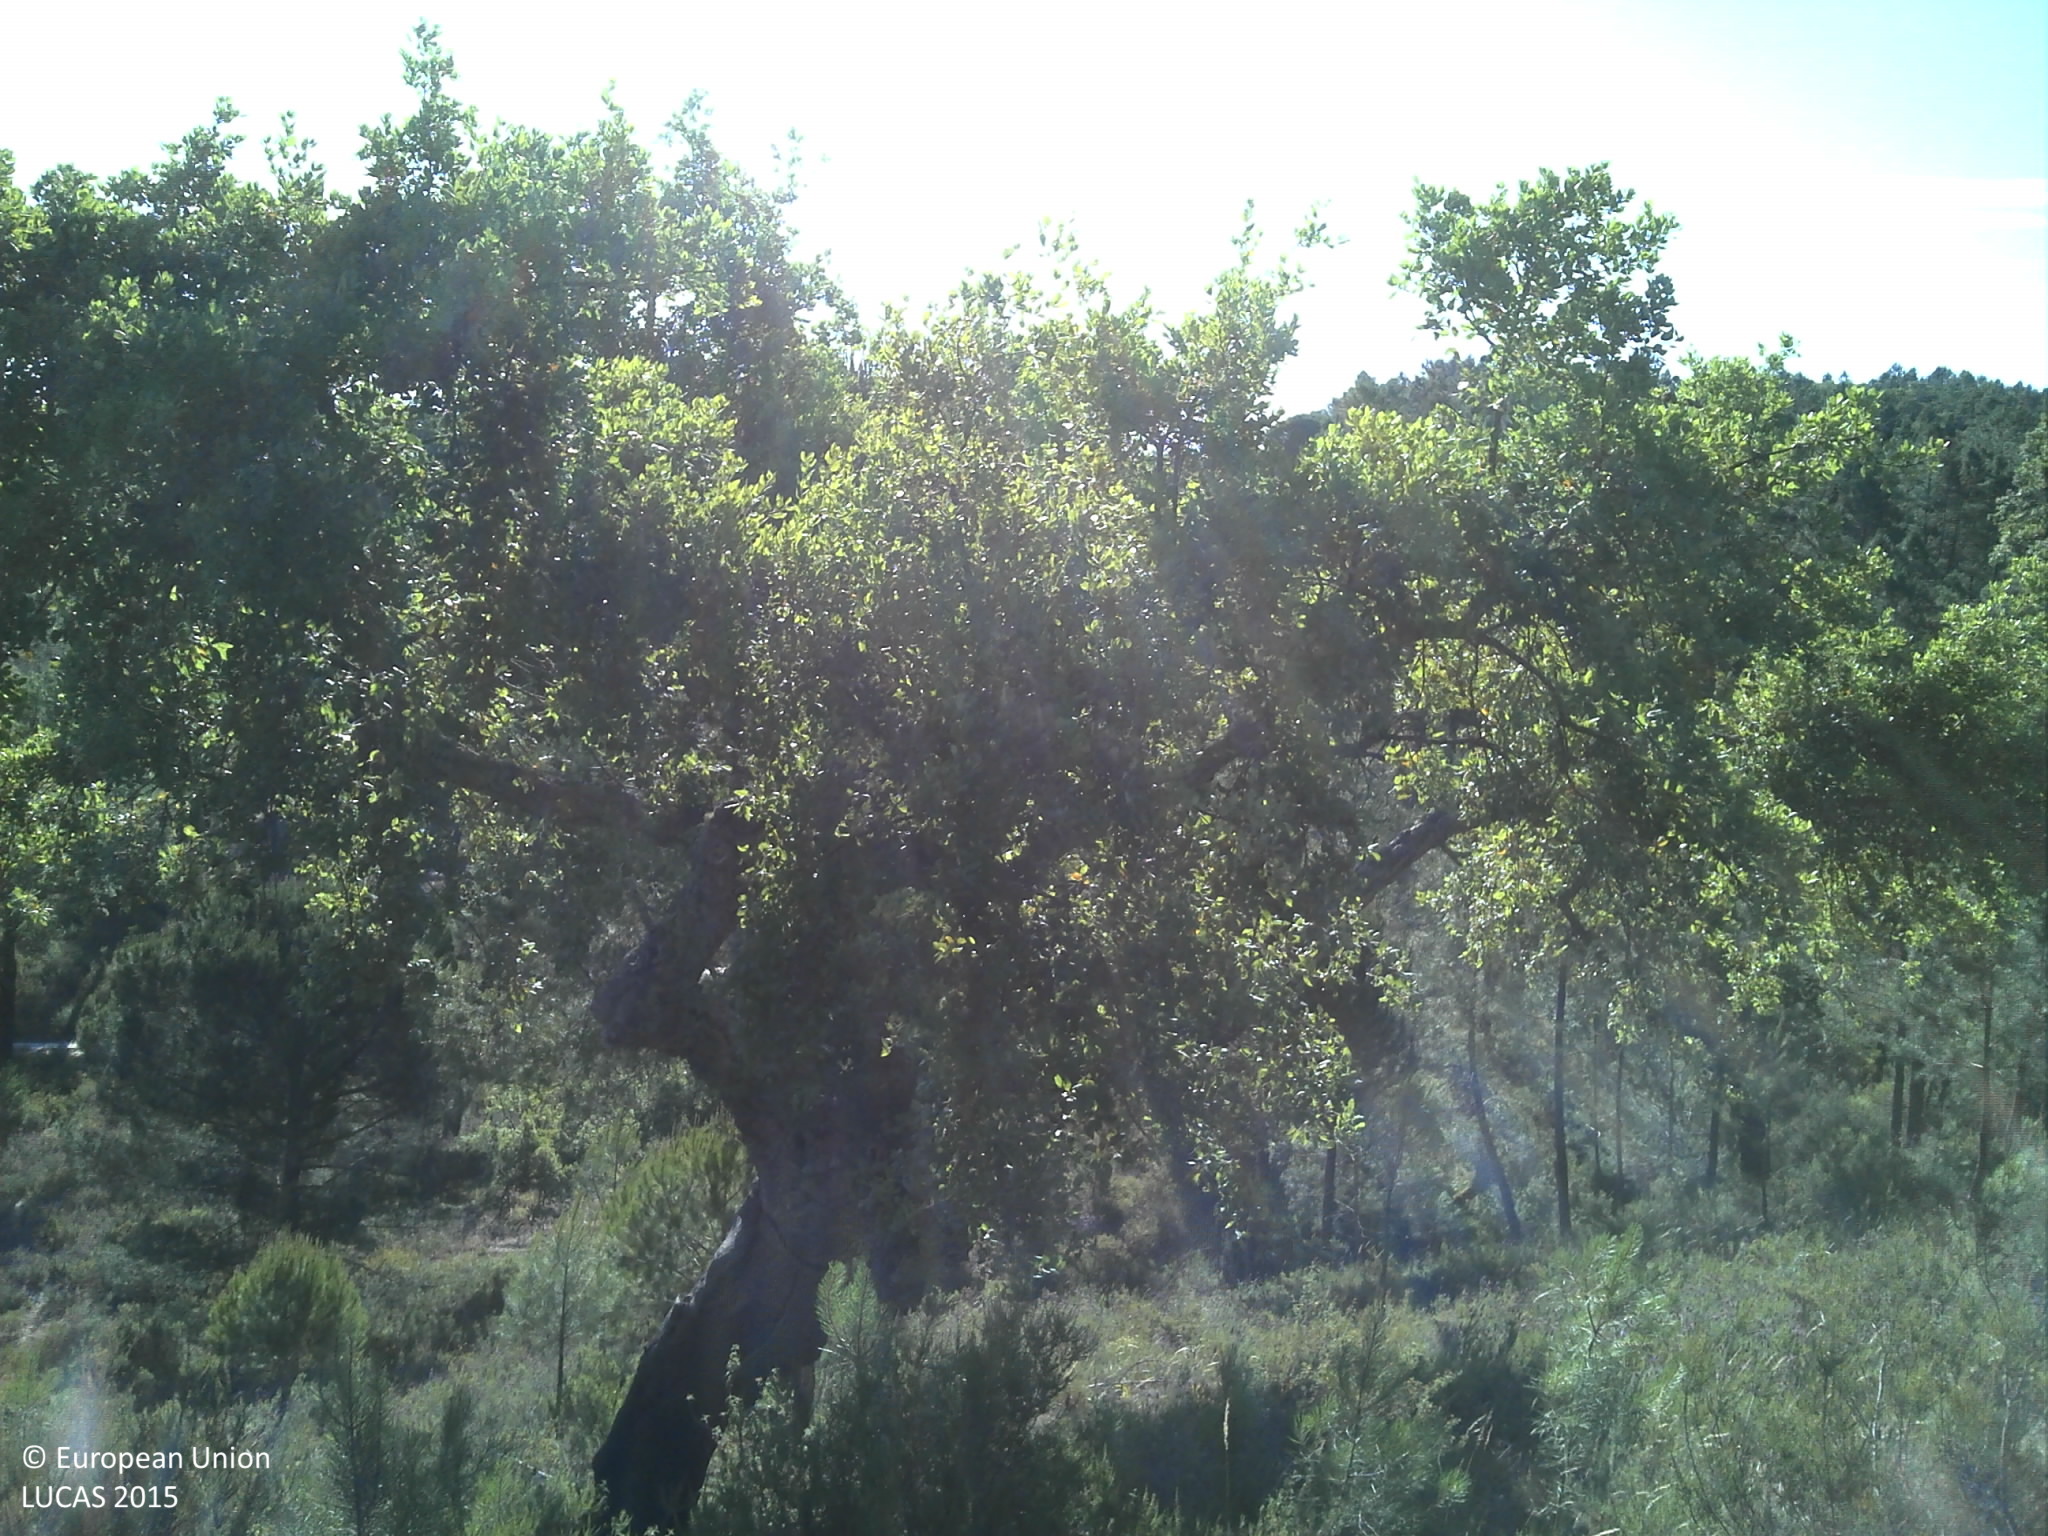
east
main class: Woodland
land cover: Broadleaved woodland
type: broadleaved evergreen forest
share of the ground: 25 - 50 %
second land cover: Shrubland without tree cover
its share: 50 - 75 %
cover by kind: broadleaved forest trees 50 %, shrubs 20 %, unconsolidated bare surface 20 %, herbaceous plants 10 %
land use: Forestry
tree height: > 5 m
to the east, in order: Broadleaved woodland; Shrubland without tree cover; Broadleaved woodland; Pine dominated coniferous woodland; Grassland with sparse tree/shrub cover; Tracks; Broadleaved woodland; Pine dominated coniferous woodland; Tracks; Pine dominated coniferous woodland
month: May
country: PT
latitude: 39.1771
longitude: -8.0072
